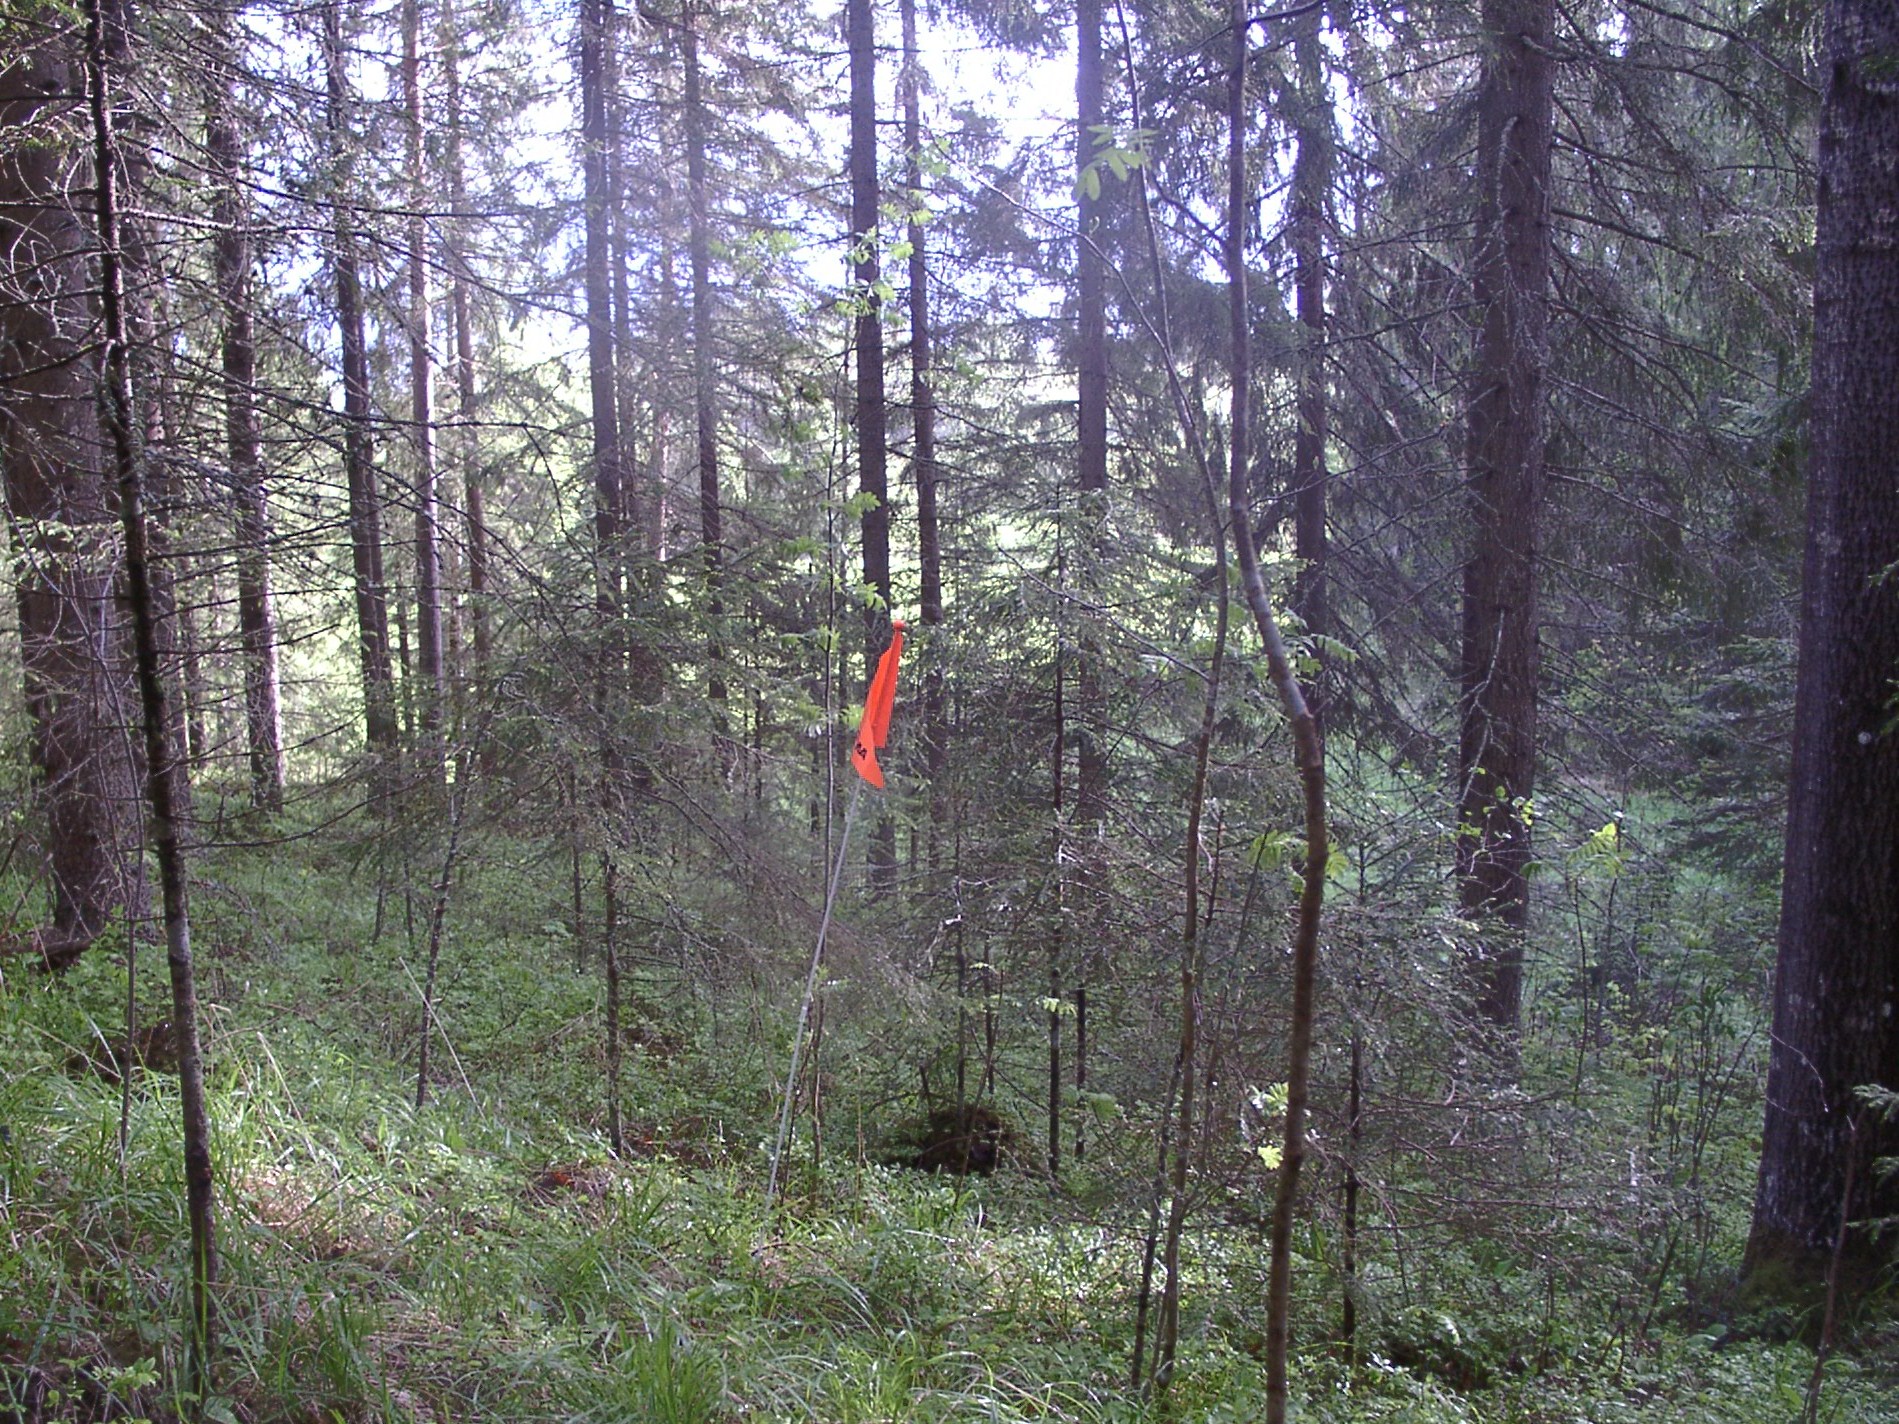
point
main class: Woodland
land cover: Spruce dominated coniferous woodland
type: boreal forest
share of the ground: 50 - 75 %
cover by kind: coniferous forest trees 65 %, shrubs 15 %, herbaceous plants 10 %, broadleaved forest trees 5 %, lichens and mosses 5 %
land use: Forestry
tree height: > 5 m
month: June
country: FI
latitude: 62.1891
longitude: 25.5045
